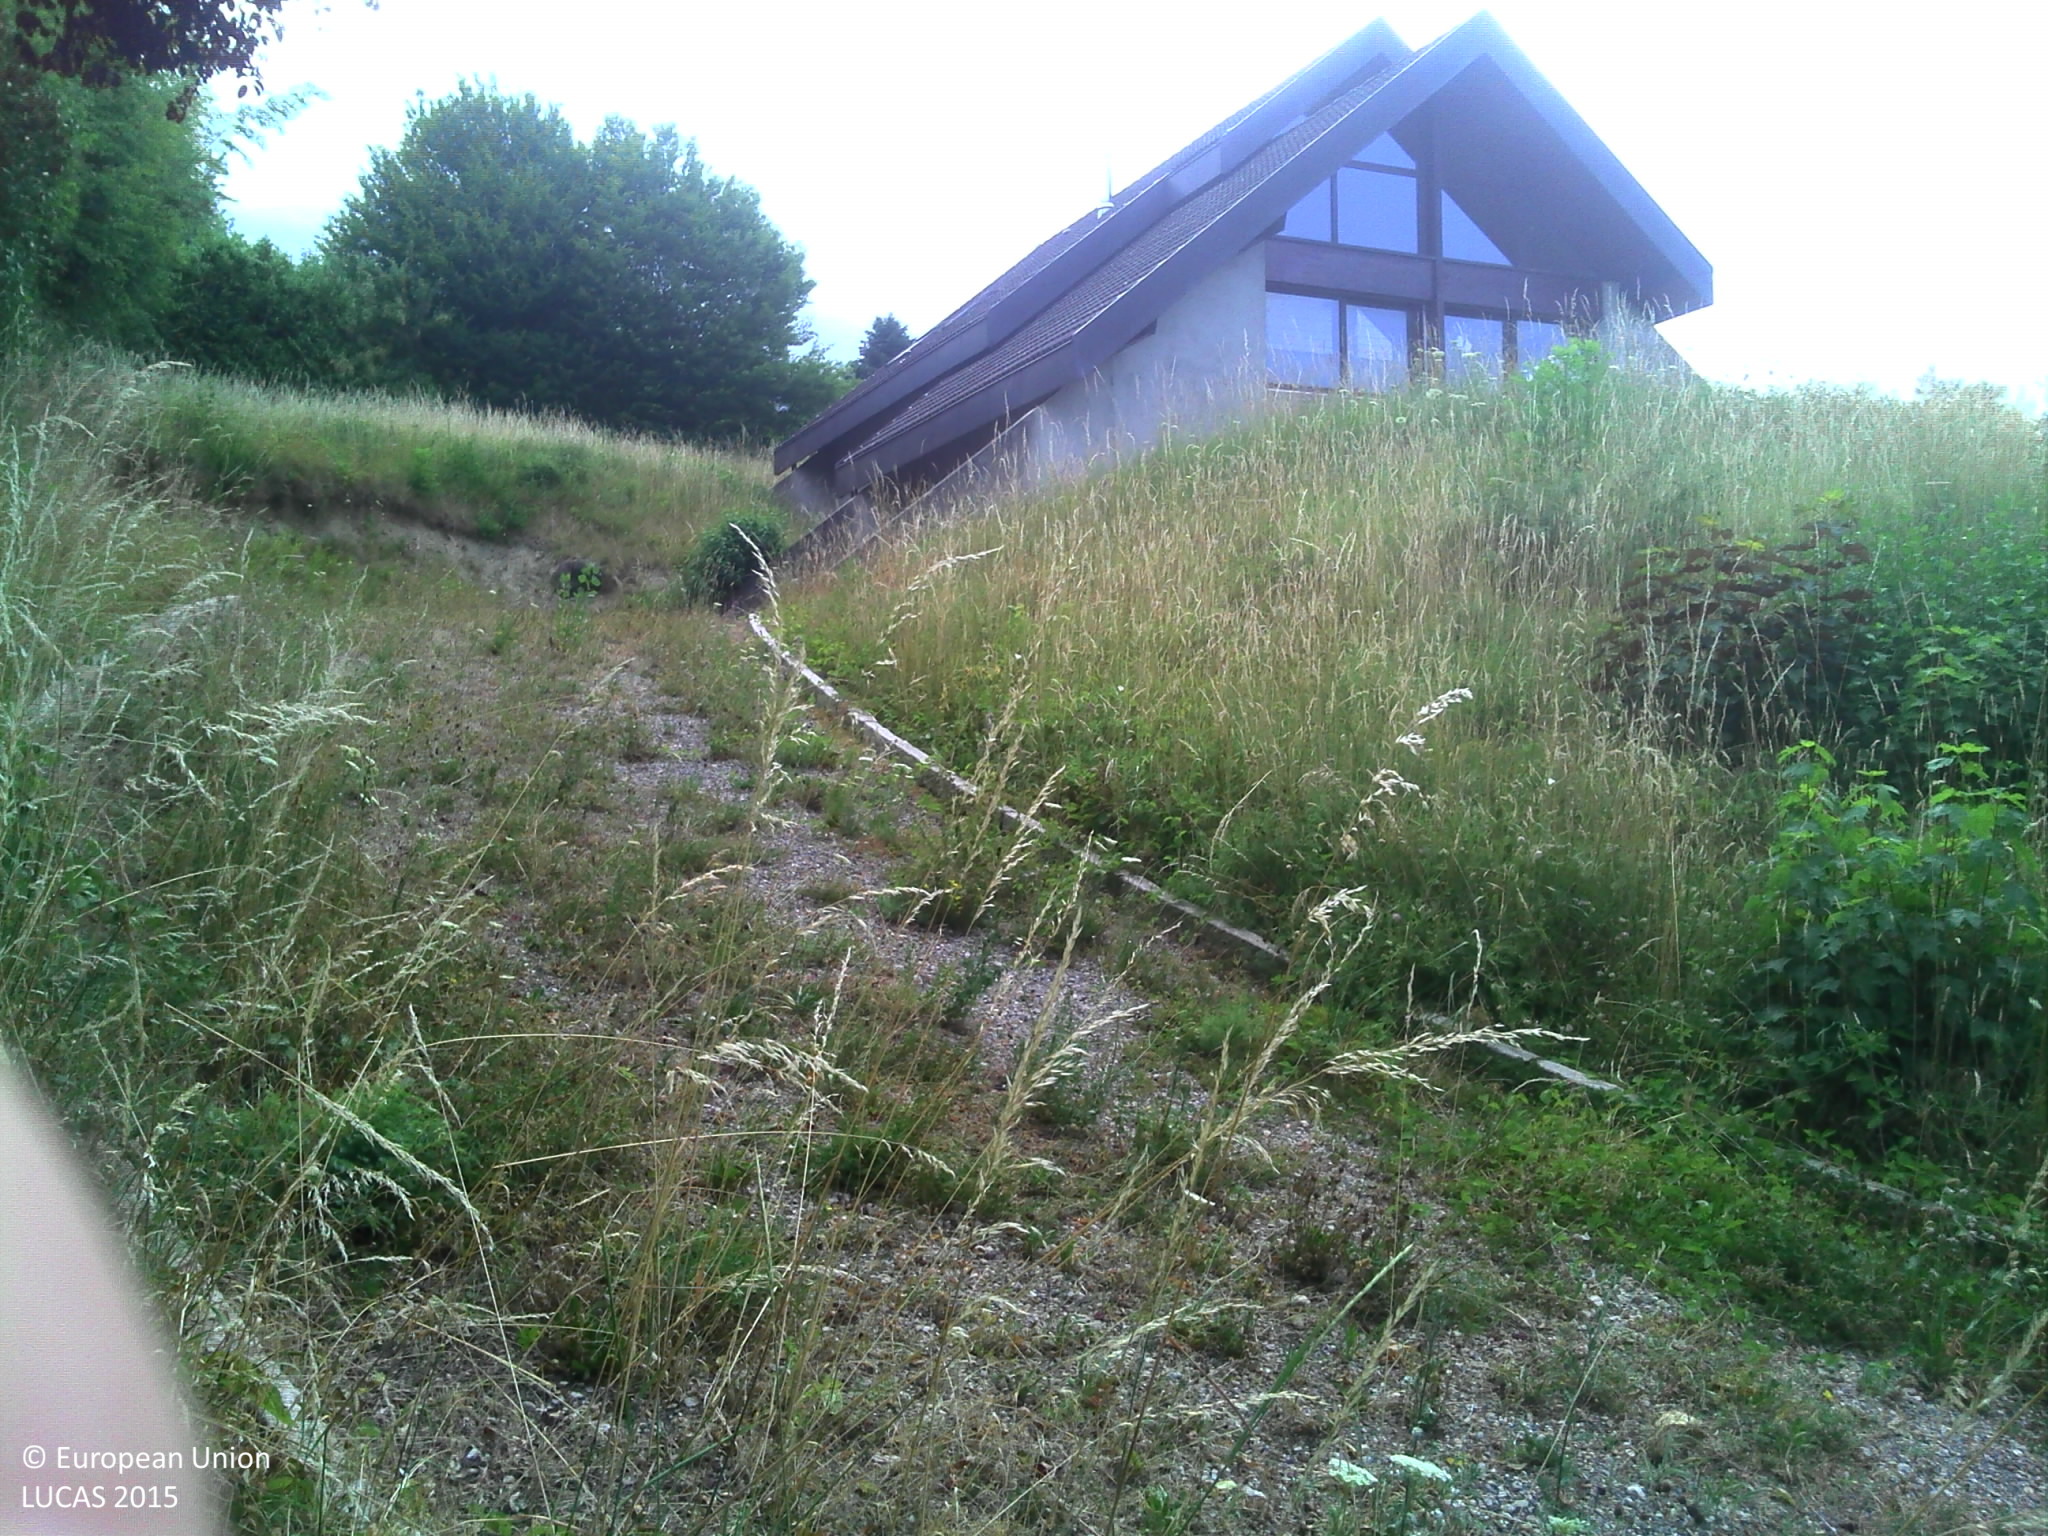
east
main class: Grassland
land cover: Grassland without tree/shrub cover
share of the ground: > 75 %
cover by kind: herbaceous plants 100 %
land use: Residential
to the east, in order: Grassland without tree/shrub cover; Tracks; Grassland without tree/shrub cover; Artificial constructions in urban areas; Grassland without tree/shrub cover; Managed hedges; Grassland with sparse tree/shrub cover; Conifer hedges; Artificial constructions in urban areas
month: July
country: FR
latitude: 46.1776
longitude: 6.2598
